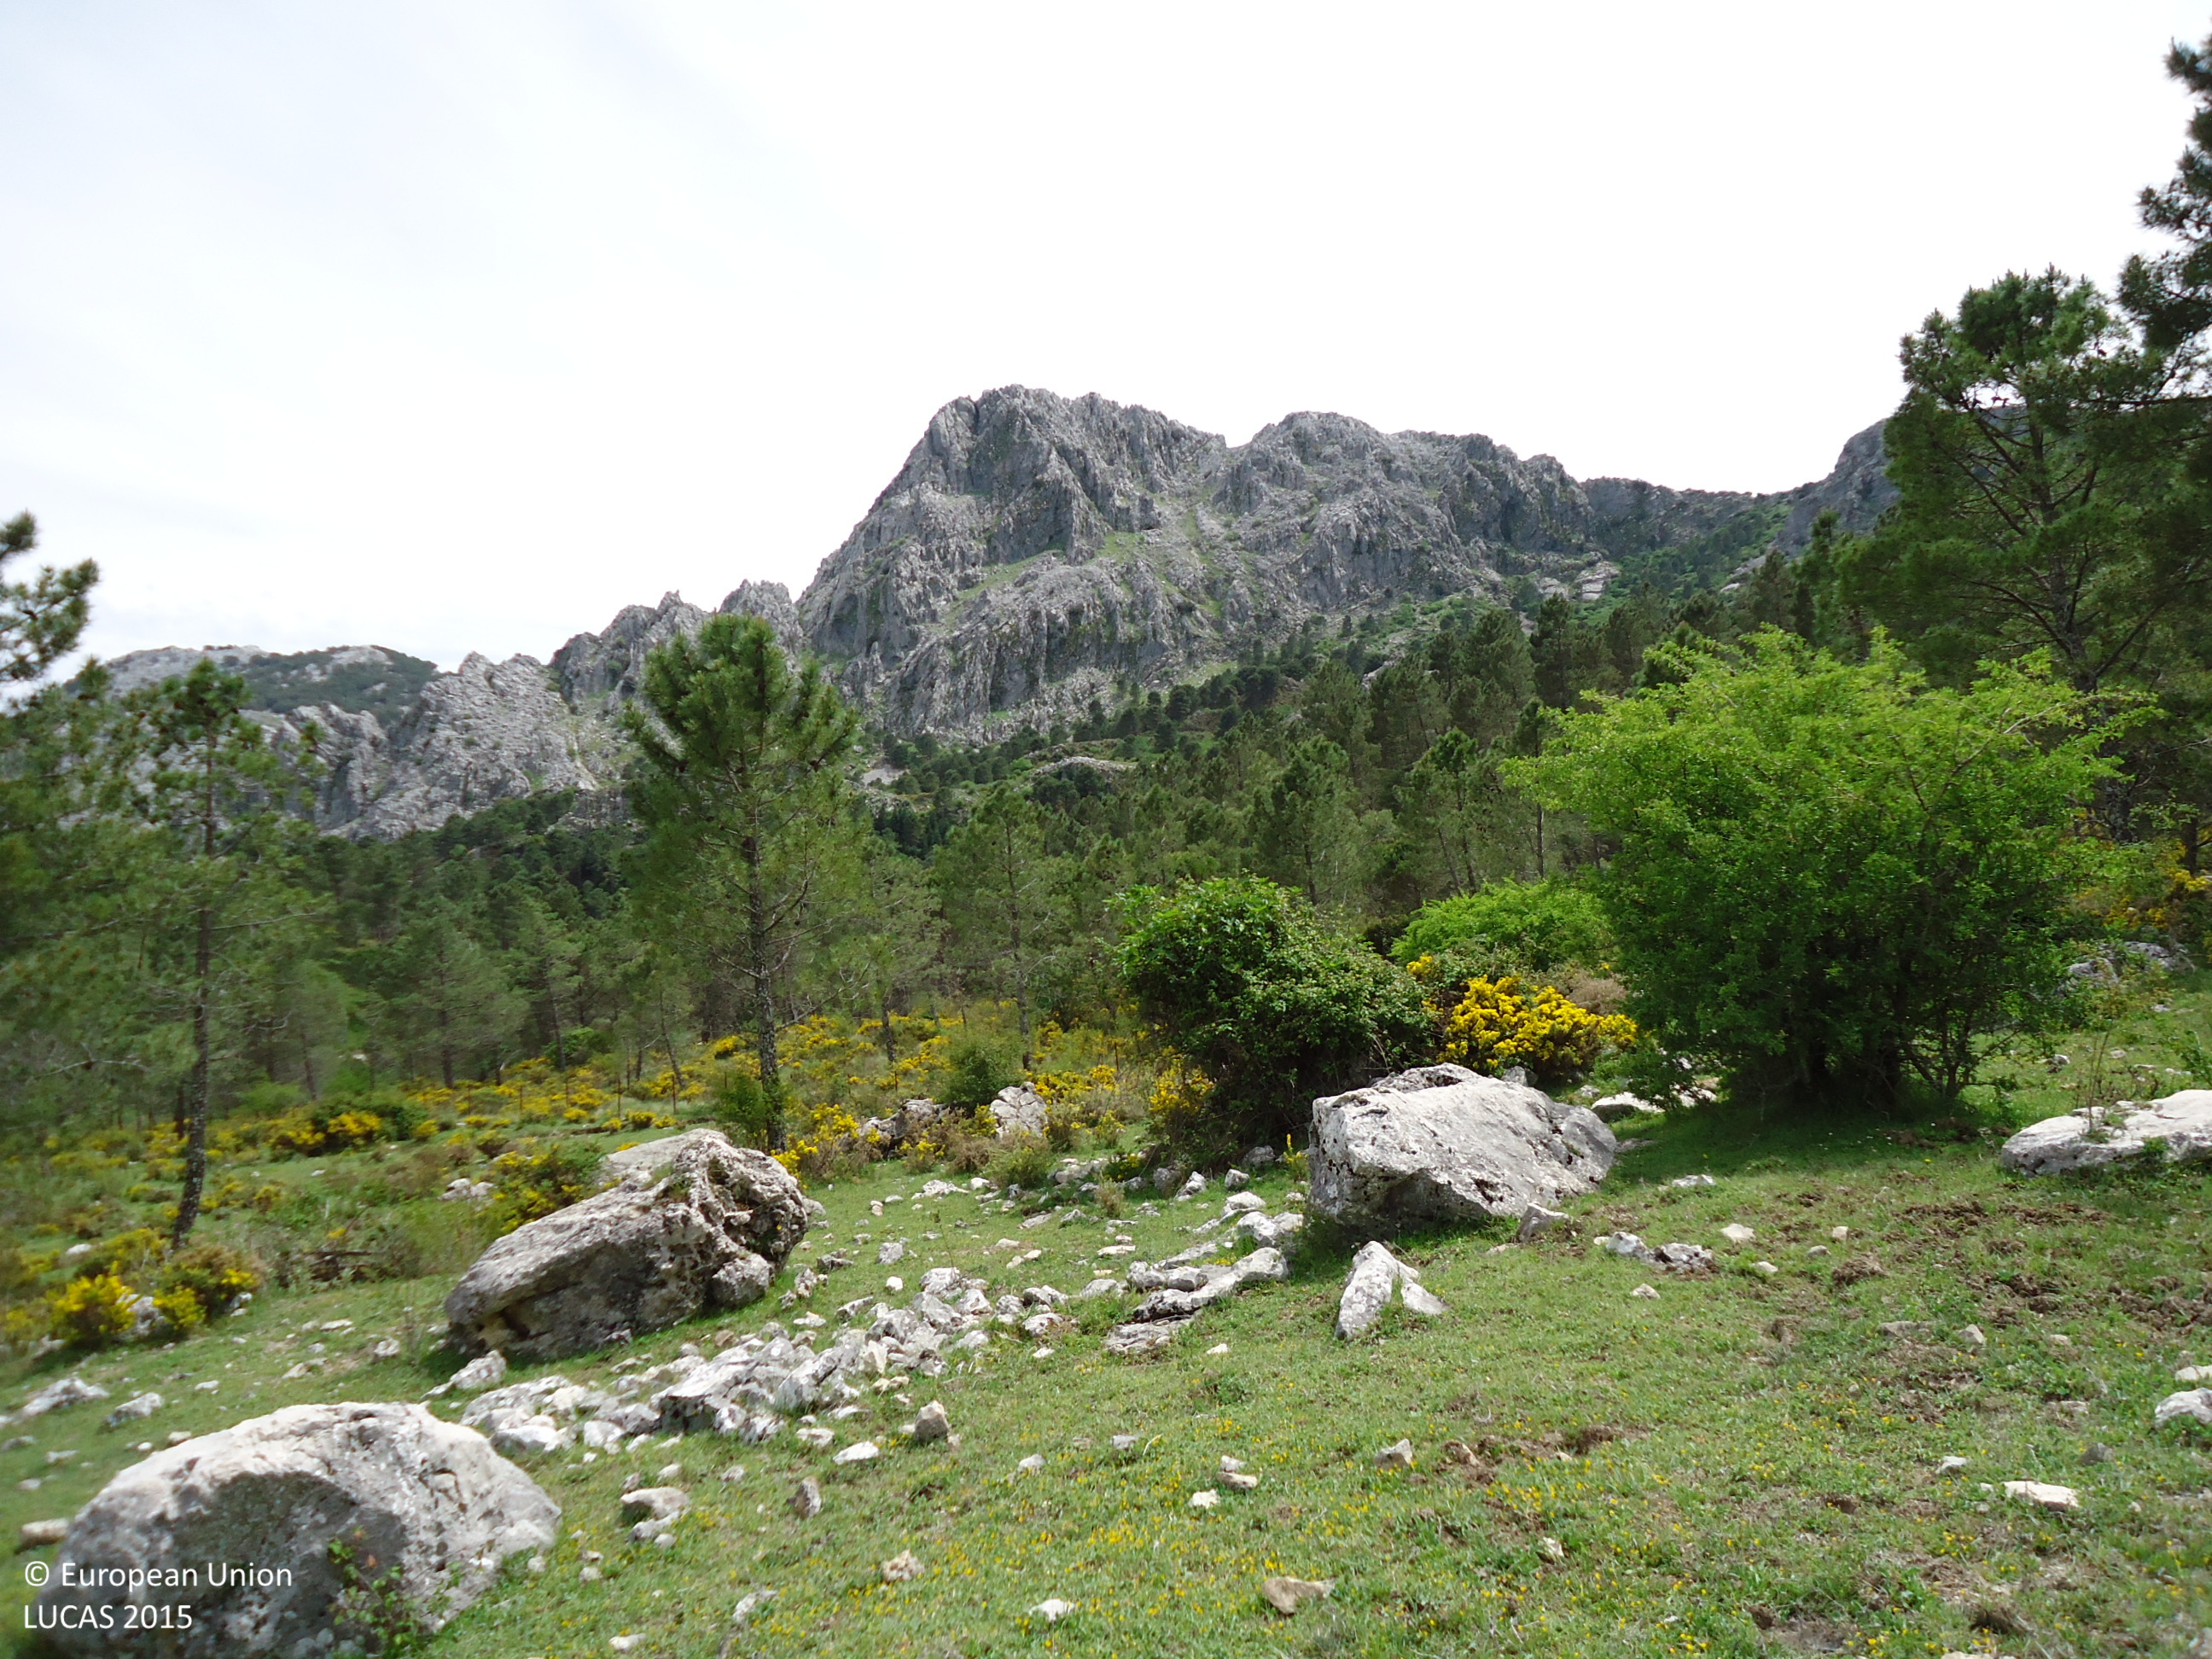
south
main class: Grassland
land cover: Grassland with sparse tree/shrub cover
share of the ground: > 75 %
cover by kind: herbaceous plants 85 %, consolidated bare surface 10 %, coniferous forest trees 5 %
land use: Agriculture (excluding fallow land and kitchen gardens)
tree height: > 5 m
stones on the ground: 10 - 25 %
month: May
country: ES
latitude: 36.7640
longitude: -5.3836
